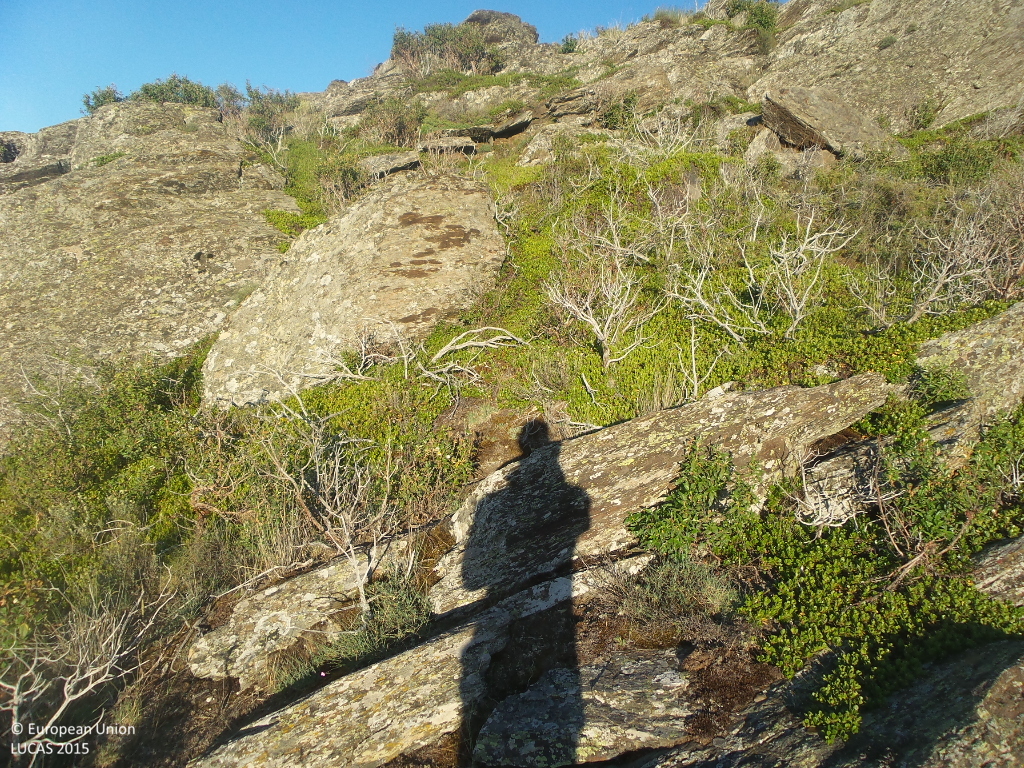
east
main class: Shrubland
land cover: Shrubland without tree cover
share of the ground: 25 - 50 %
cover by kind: shrubs 40 %, consolidated bare surface 40 %, unconsolidated bare surface 20 %
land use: Semi-natural and natural areas not in use
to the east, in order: Shrubland without tree cover; Rivers and streams; Shrubland without tree cover
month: June
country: ES
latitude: 41.2058
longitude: -3.0255
